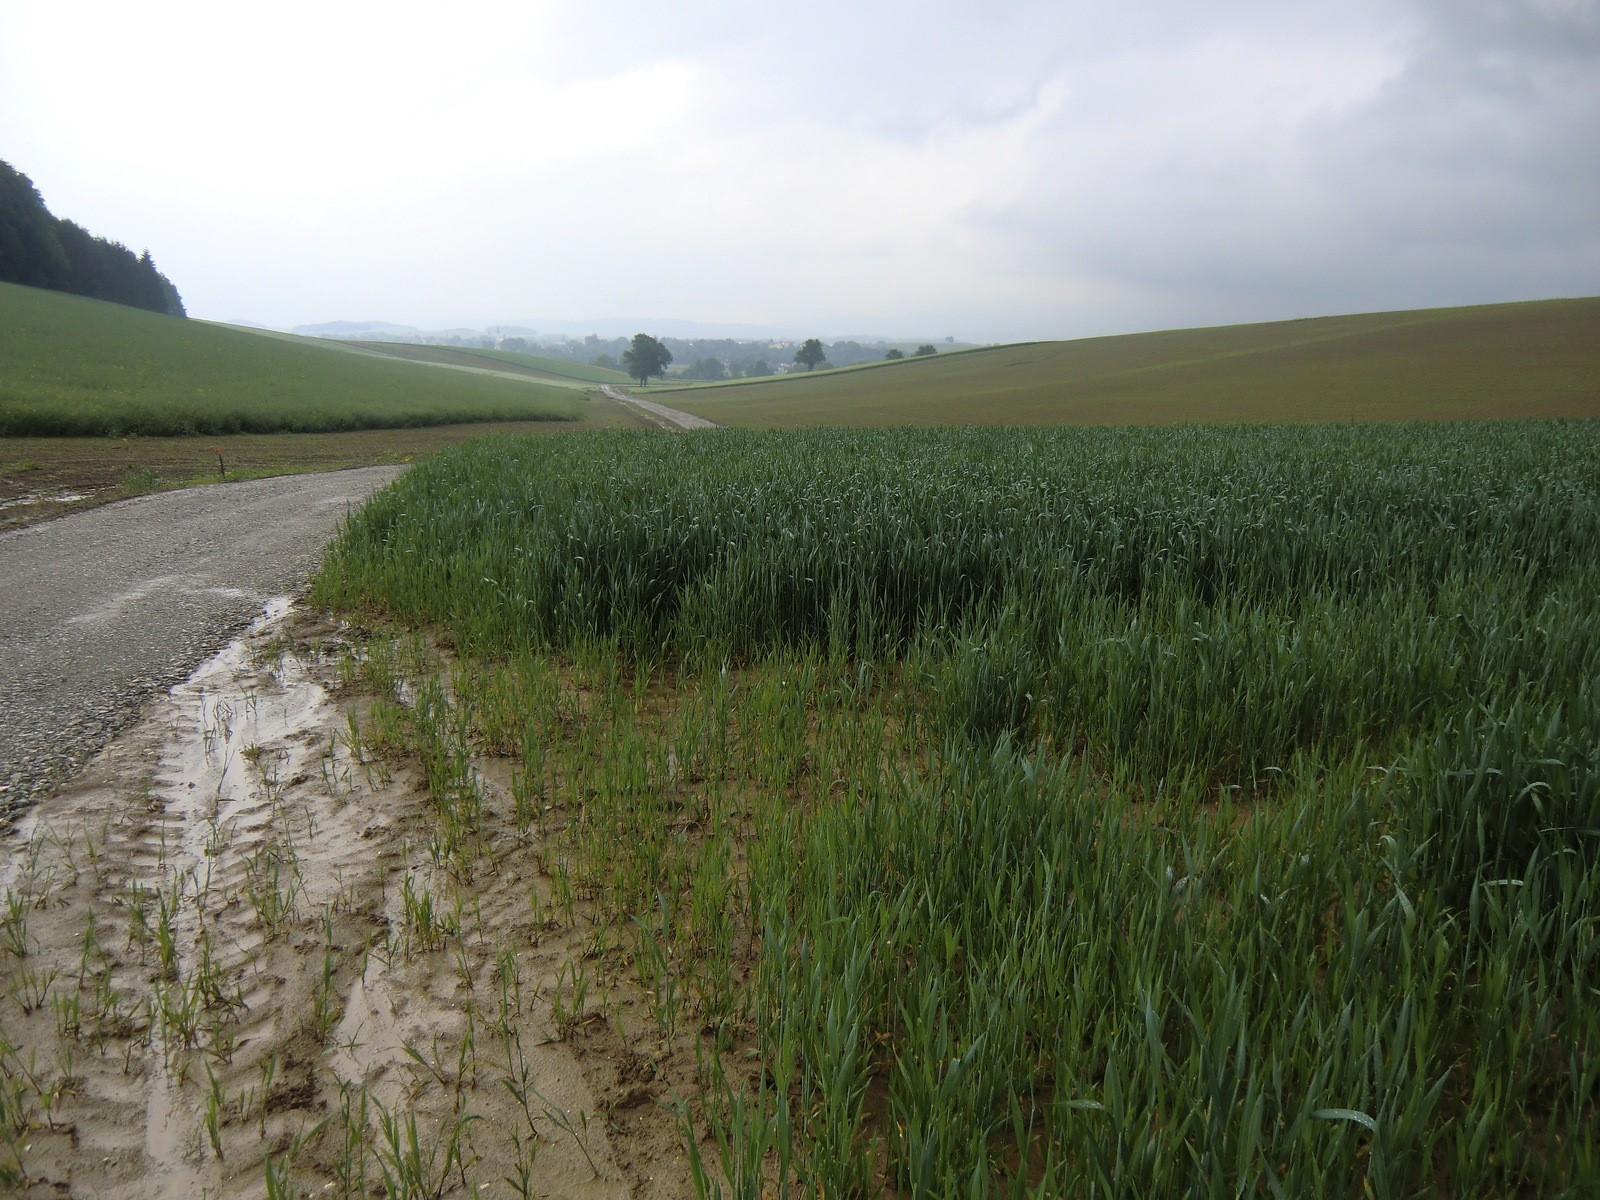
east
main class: Cropland
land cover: Common wheat
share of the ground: > 75 %
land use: Agriculture (excluding fallow land and kitchen gardens)
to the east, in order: Common wheat; Tracks; Other bare soil; Rape and turnip rape
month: May
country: AT
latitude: 48.1138
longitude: 15.3074
